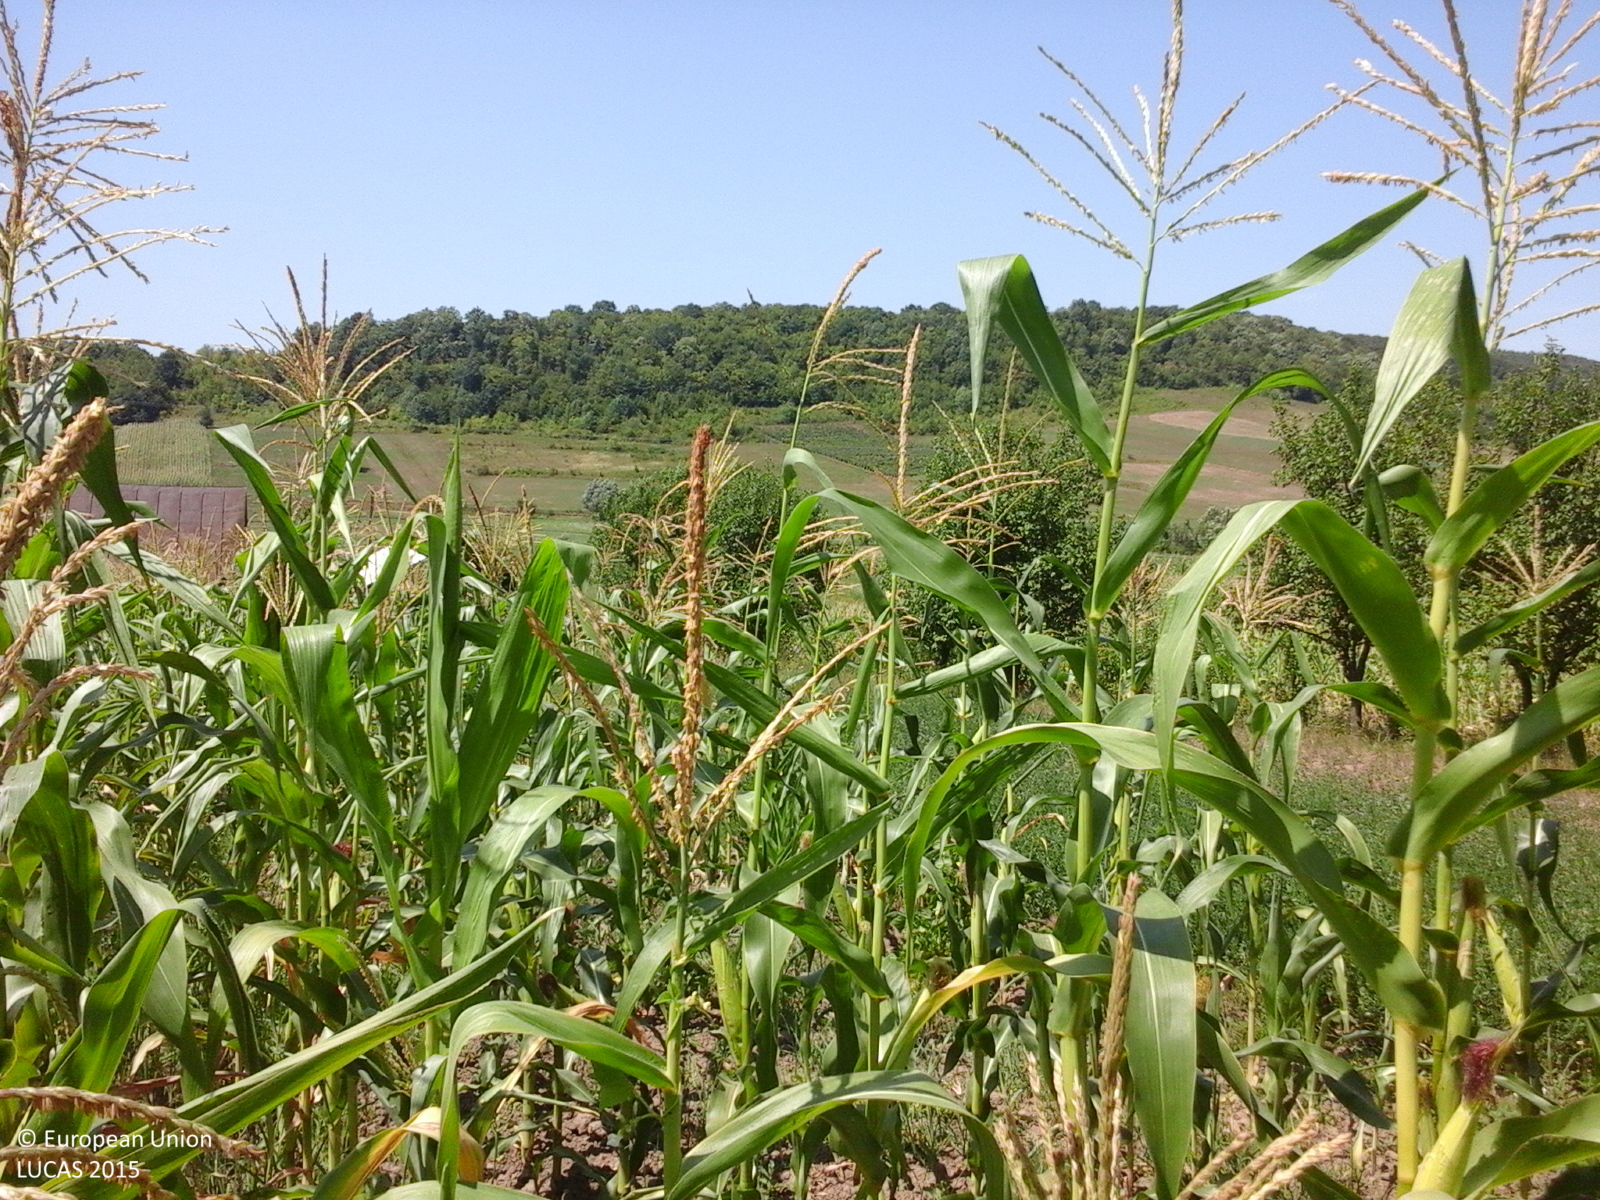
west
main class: Cropland
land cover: Maize
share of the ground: > 75 %
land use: Agriculture (excluding fallow land and kitchen gardens)
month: July
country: RO
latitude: 46.5063
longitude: 27.2128
